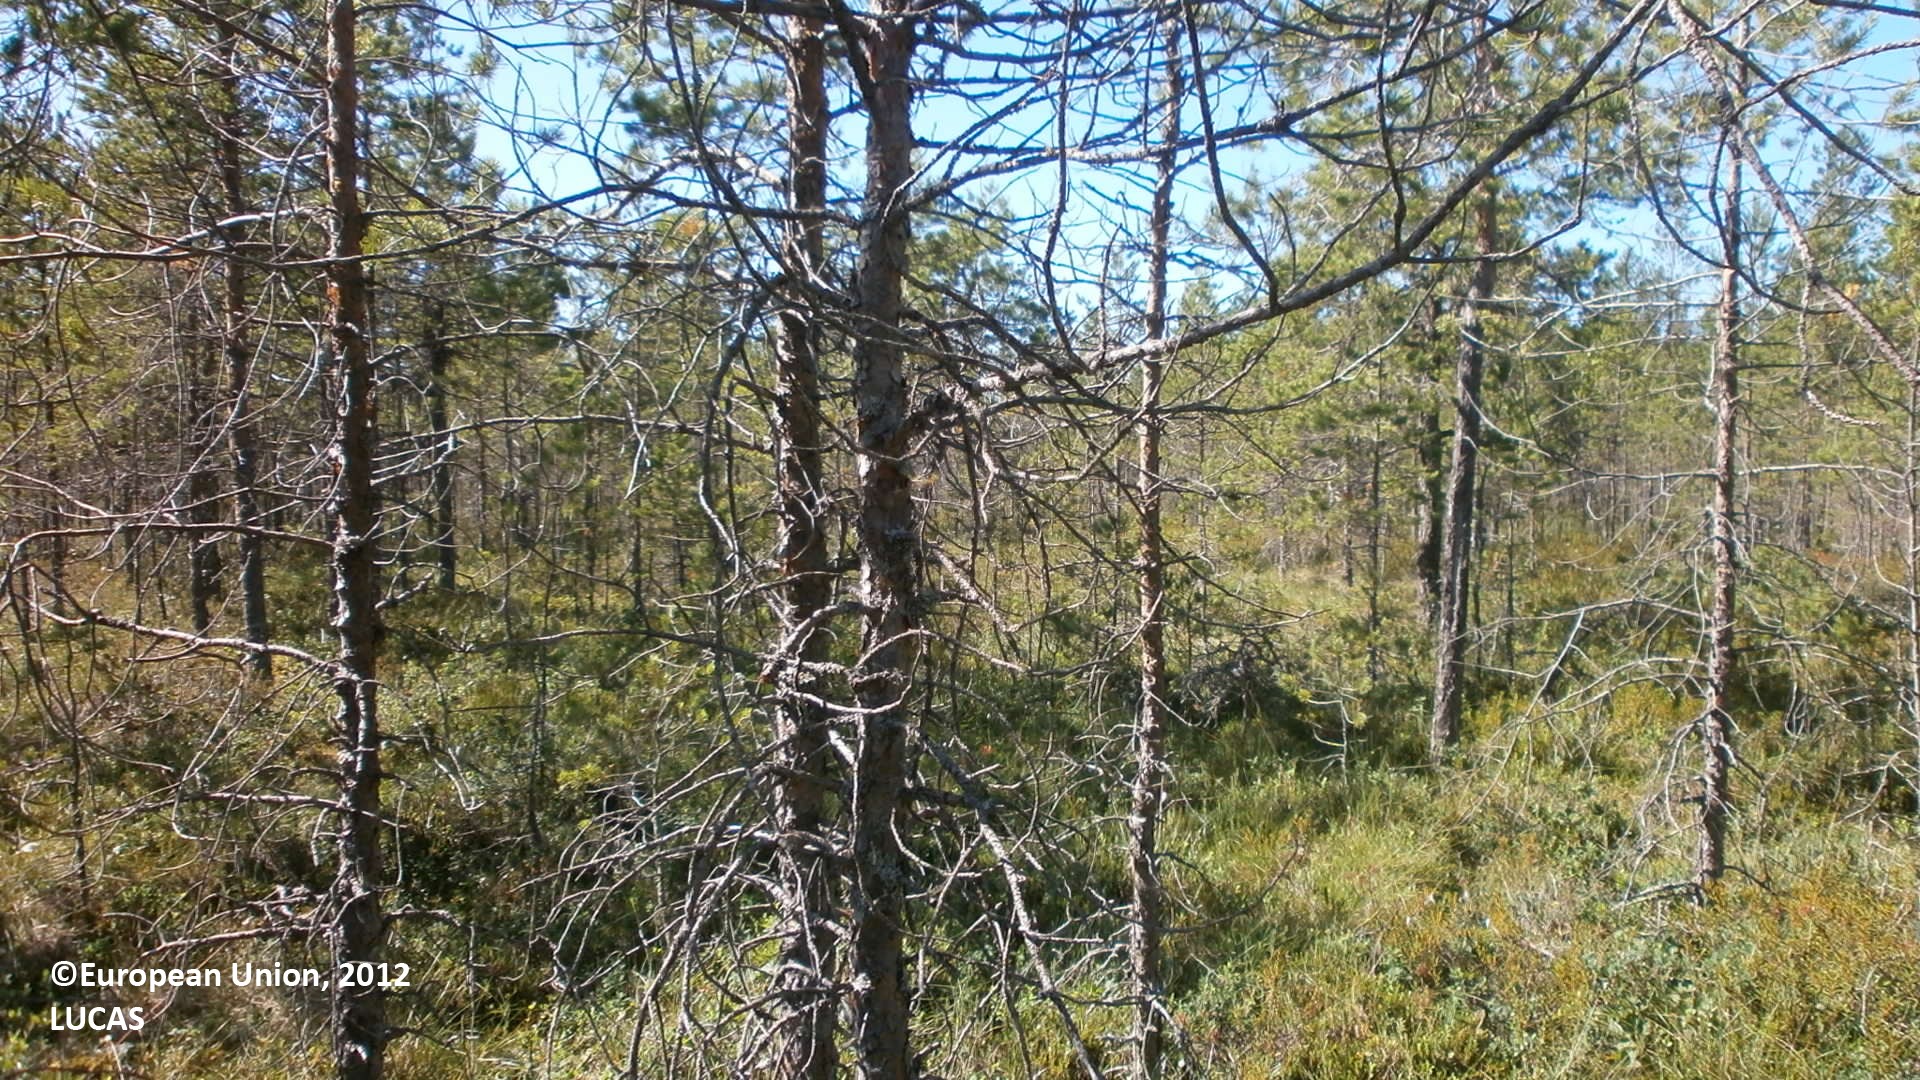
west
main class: Woodland
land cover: Pine dominated coniferous woodland
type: mire and swamp forests
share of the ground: 25 - 50 %
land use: Forestry
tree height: > 5 m
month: July
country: FI
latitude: 64.1720
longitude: 23.8653
